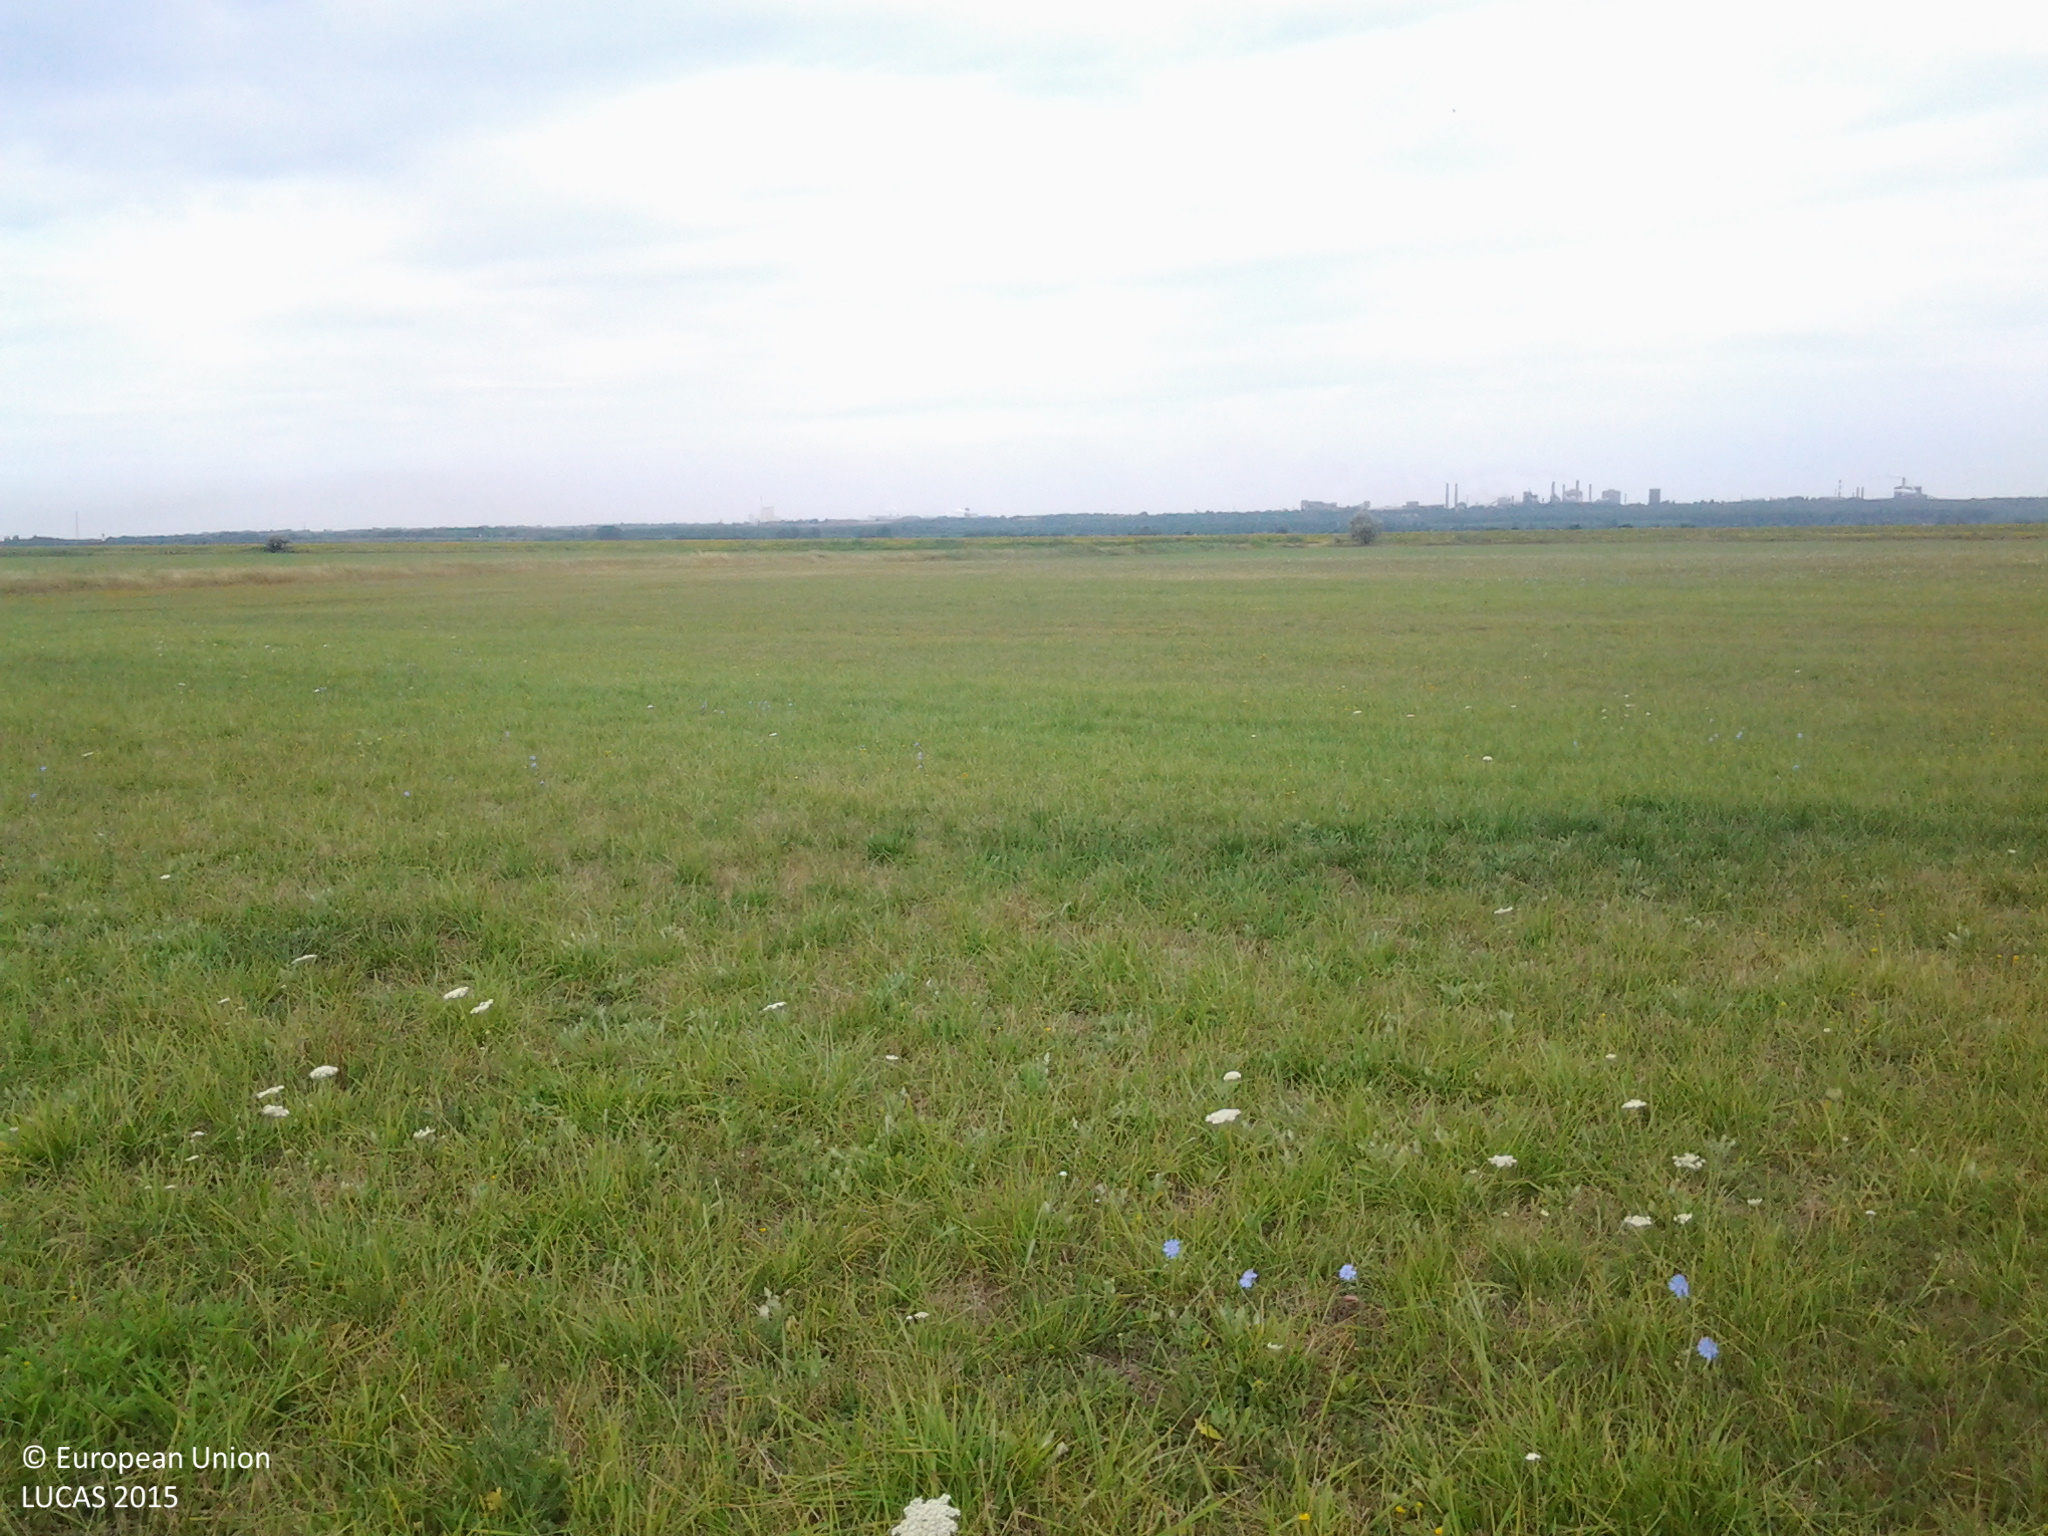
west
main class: Grassland
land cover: Grassland without tree/shrub cover
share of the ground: > 75 %
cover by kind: herbaceous plants 100 %
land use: Agriculture (excluding fallow land and kitchen gardens)
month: July
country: HU
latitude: 46.9481
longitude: 19.0153
